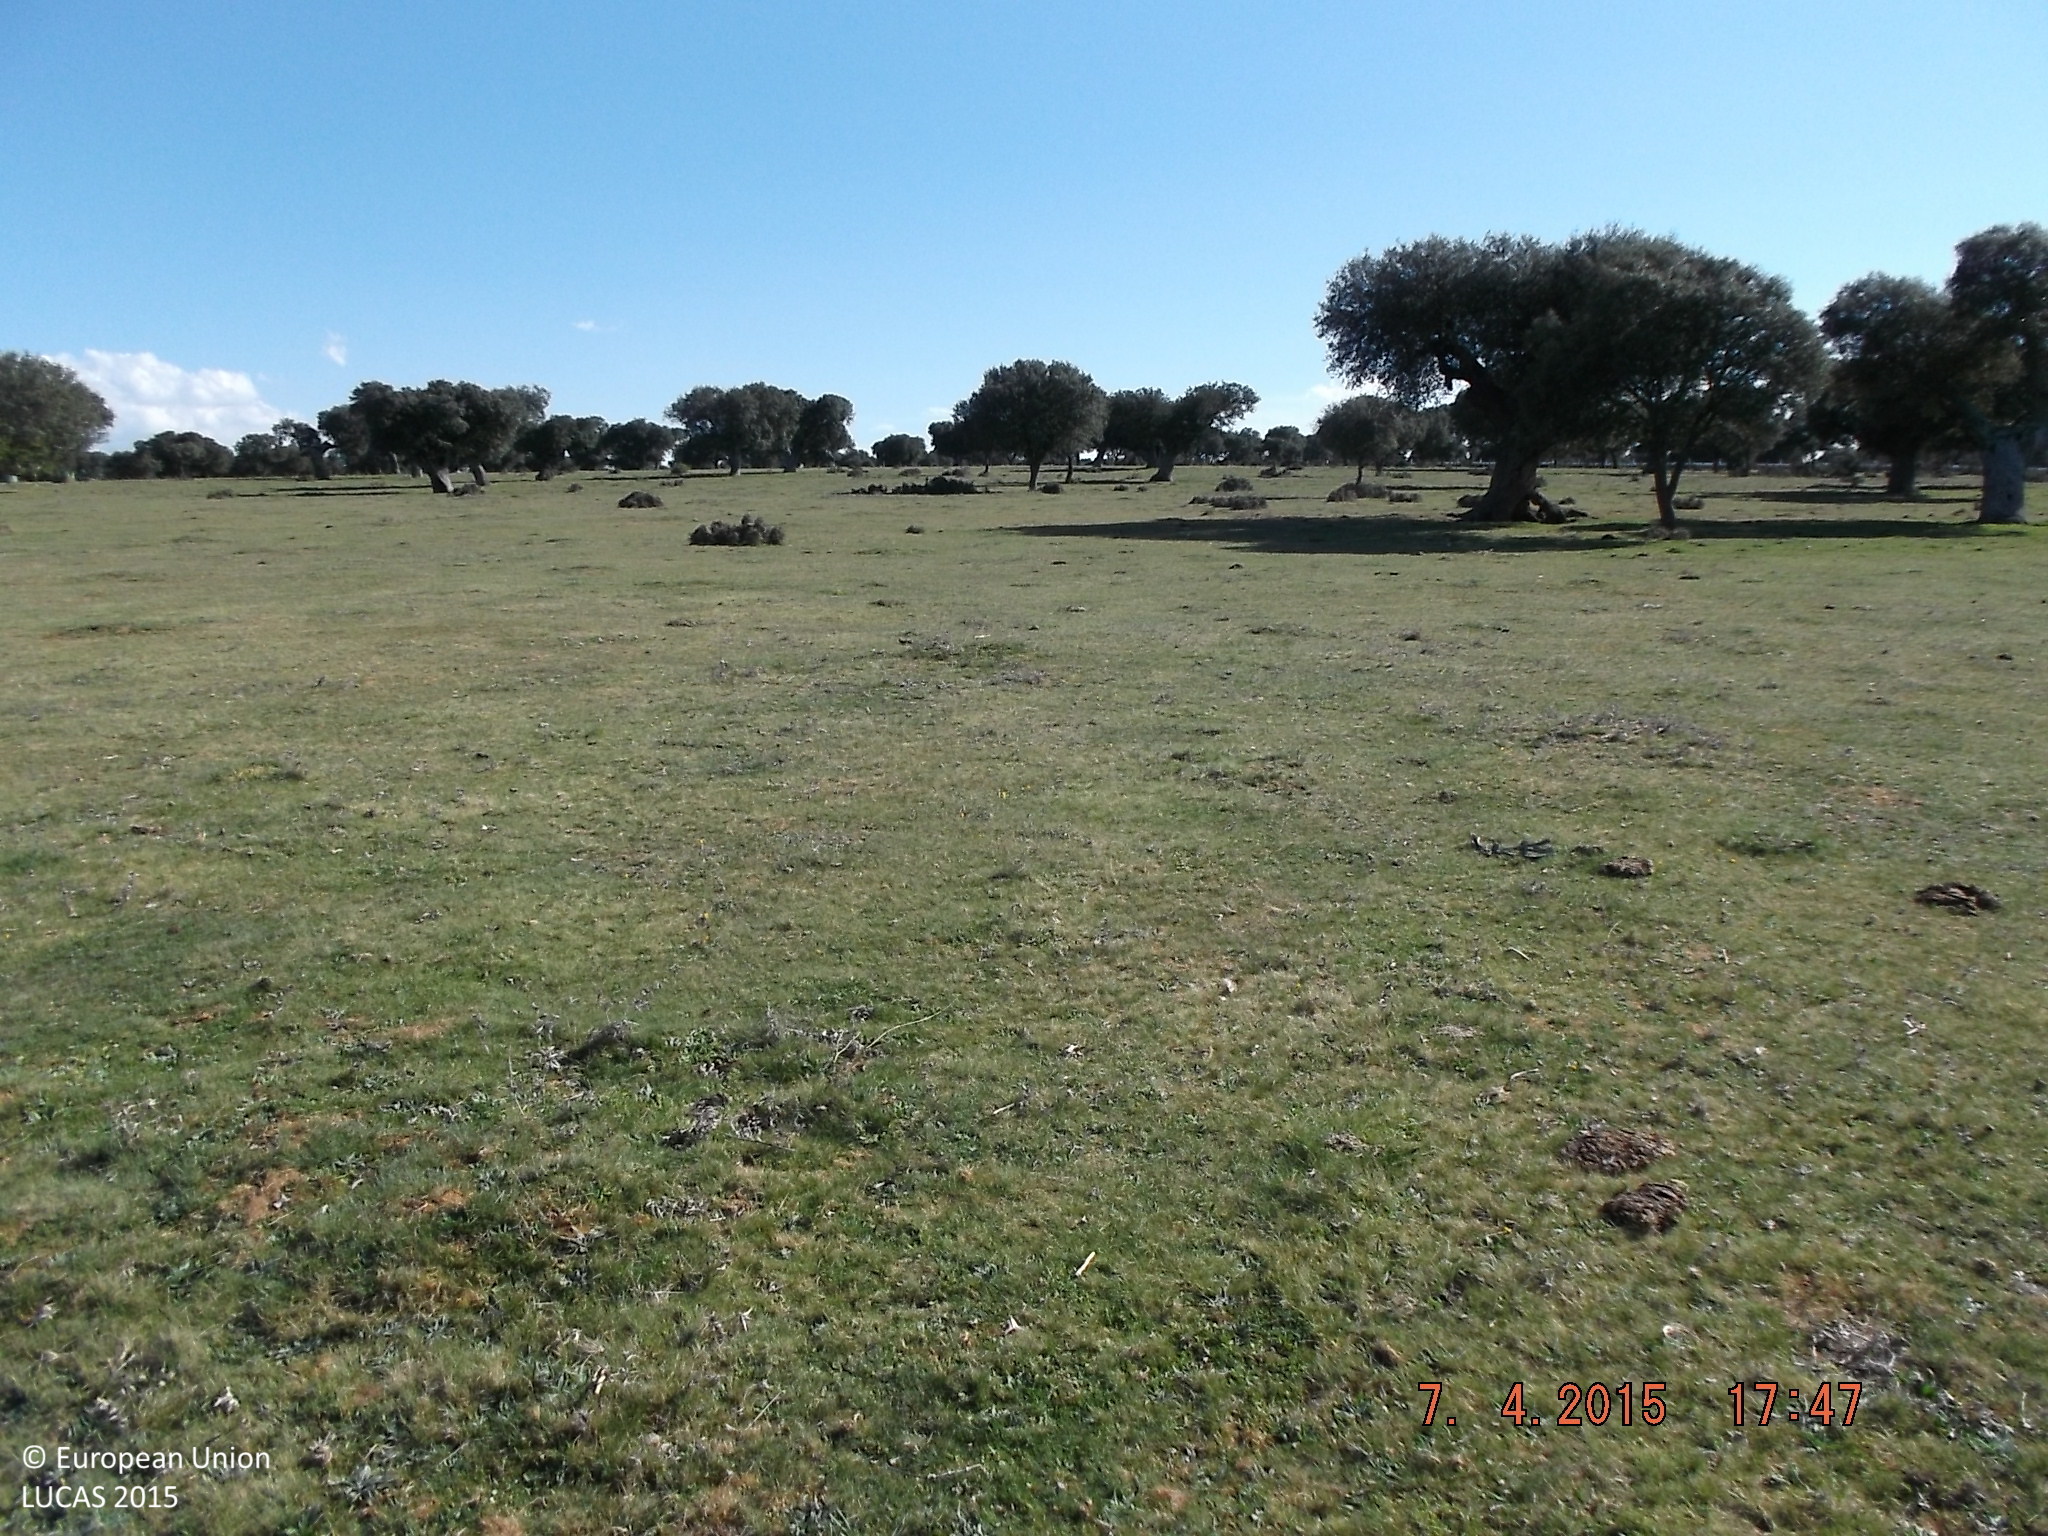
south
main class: Grassland
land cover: Grassland without tree/shrub cover
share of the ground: > 75 %
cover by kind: herbaceous plants 100 %
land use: Agriculture (excluding fallow land and kitchen gardens)
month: April
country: ES
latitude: 40.8139
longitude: -5.9308
